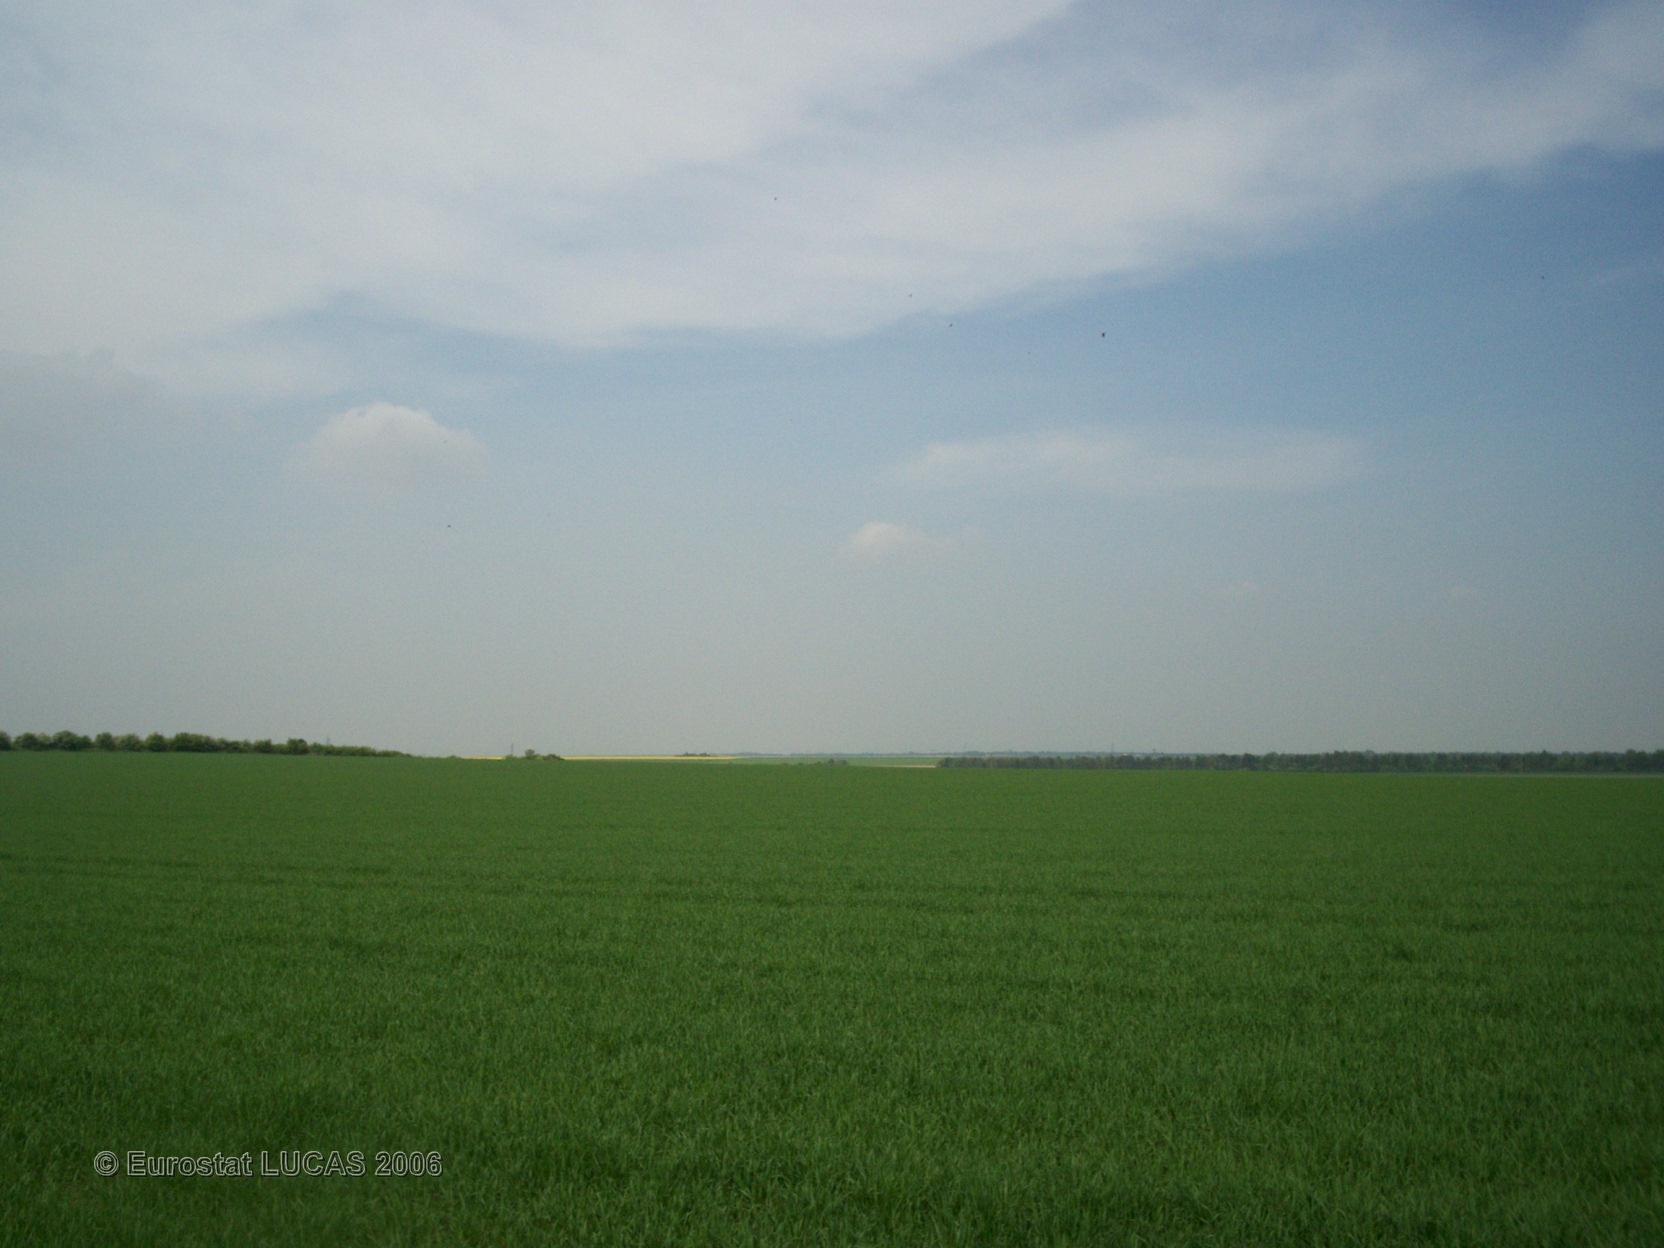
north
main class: Cropland
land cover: Rape and turnip rape
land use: Agriculture (excluding fallow land and kitchen gardens)
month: May
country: FR
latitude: 48.9847
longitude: 4.4350
